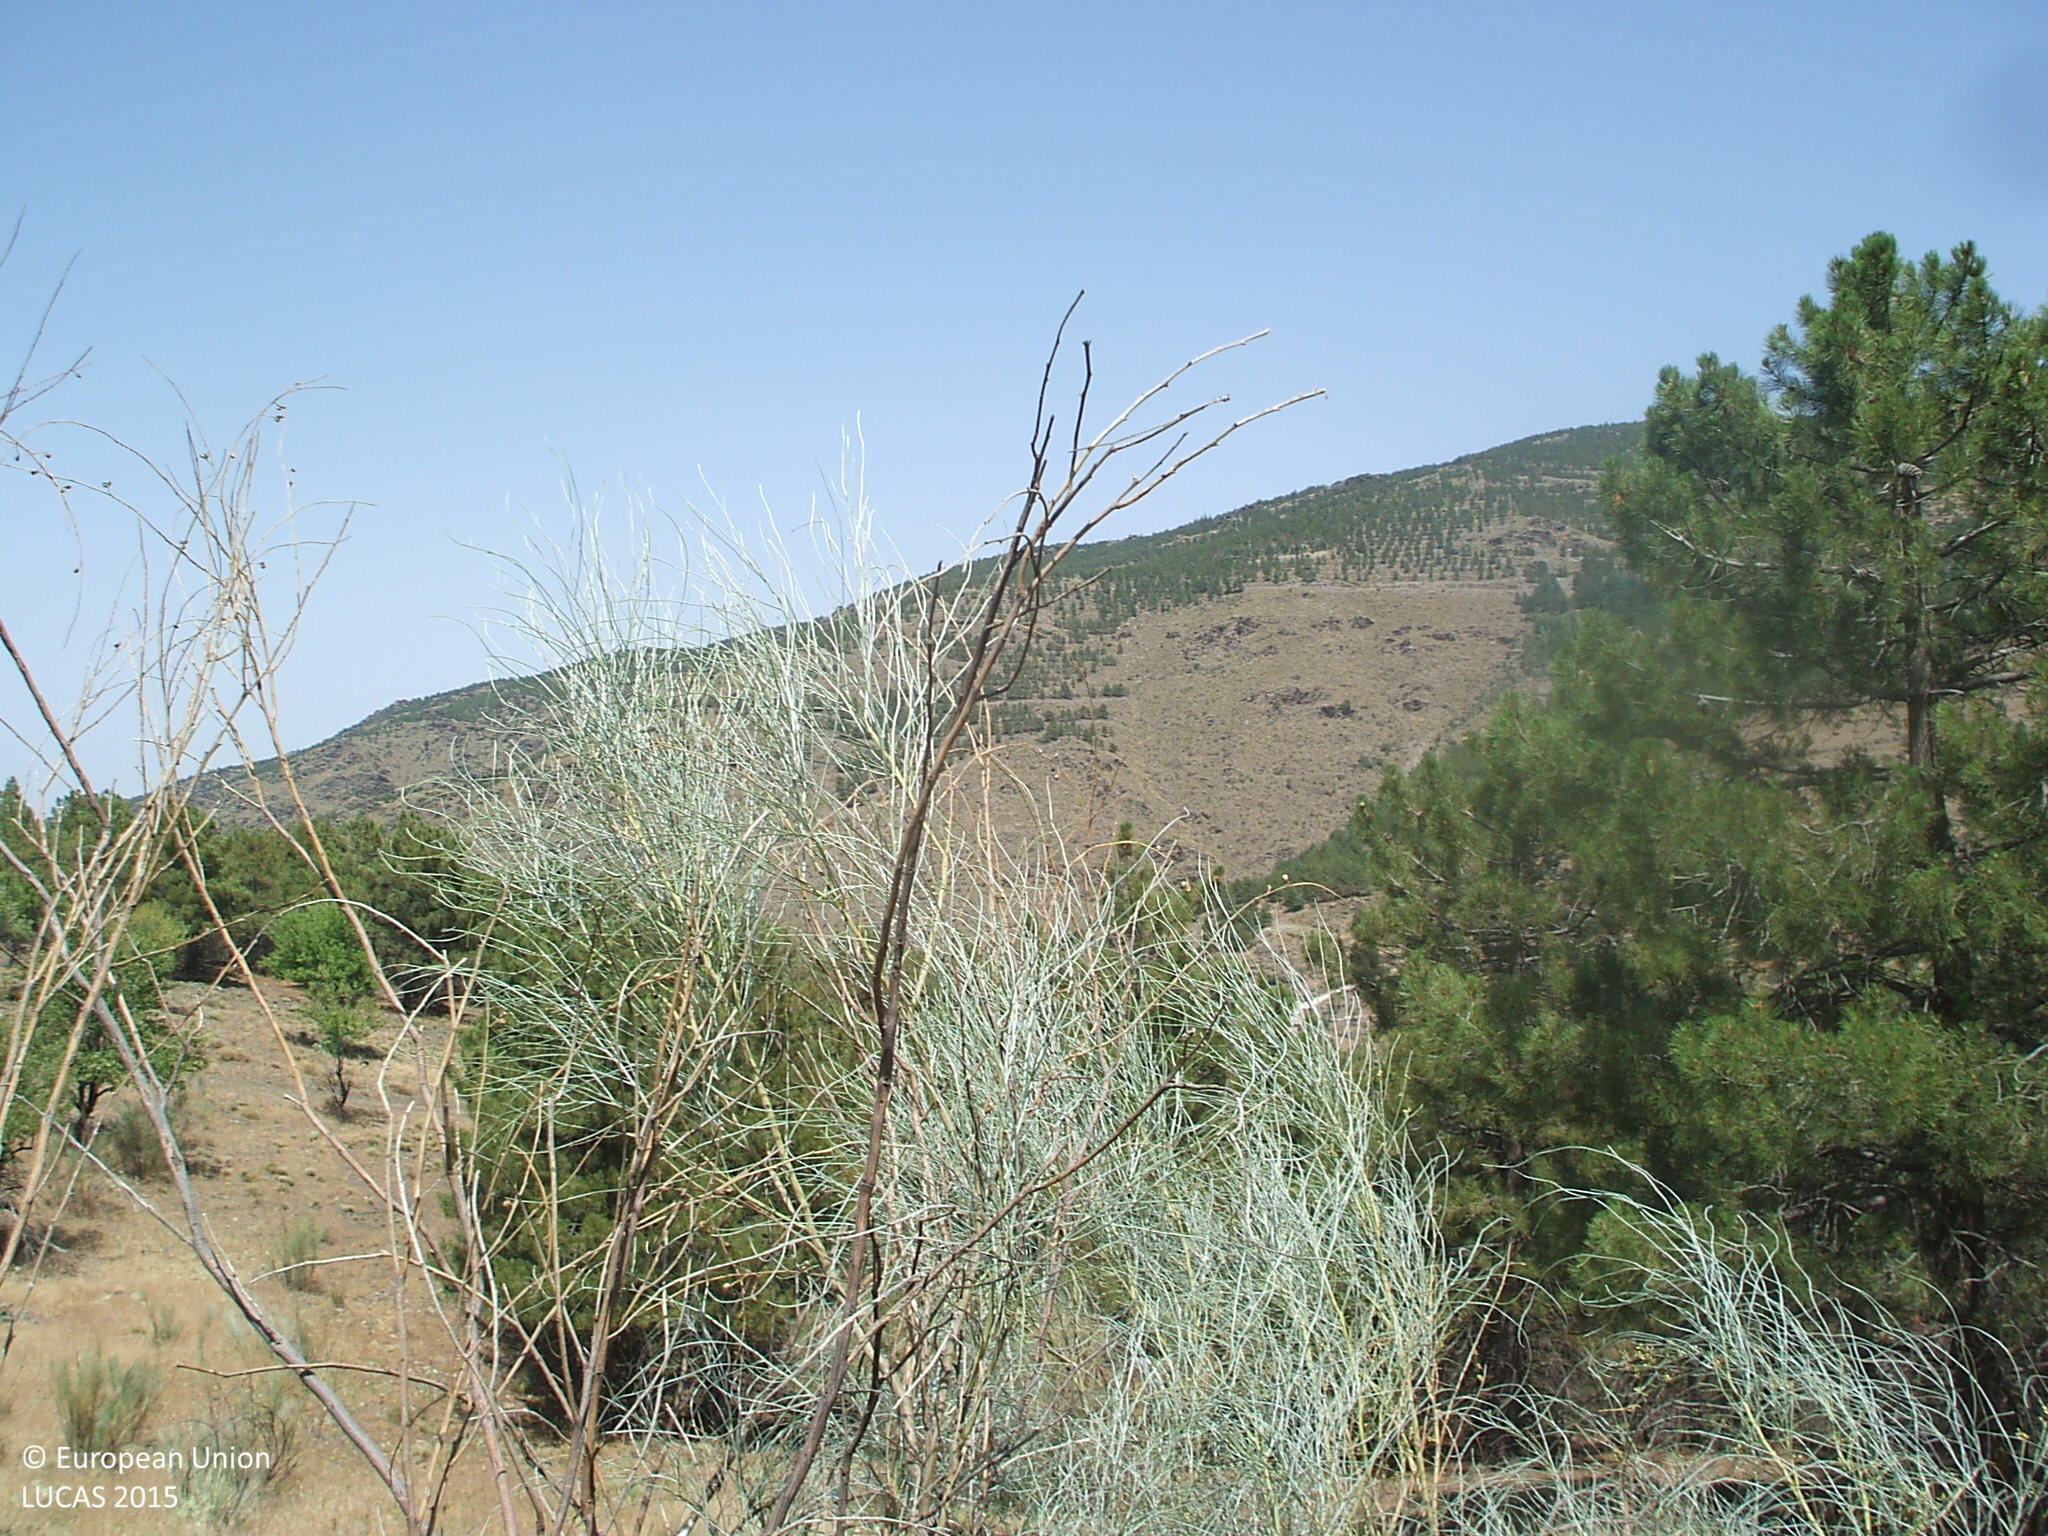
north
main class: Woodland
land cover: Pine dominated coniferous woodland
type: coniferous forest of the mediterranean region
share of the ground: 10 - 25 %
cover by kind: herbaceous plants 40 %, shrubs 30 %, coniferous forest trees 15 %, consolidated bare surface 15 %
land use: Semi-natural and natural areas not in use
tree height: > 5 m
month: July
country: ES
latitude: 37.2663
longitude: -2.6462
